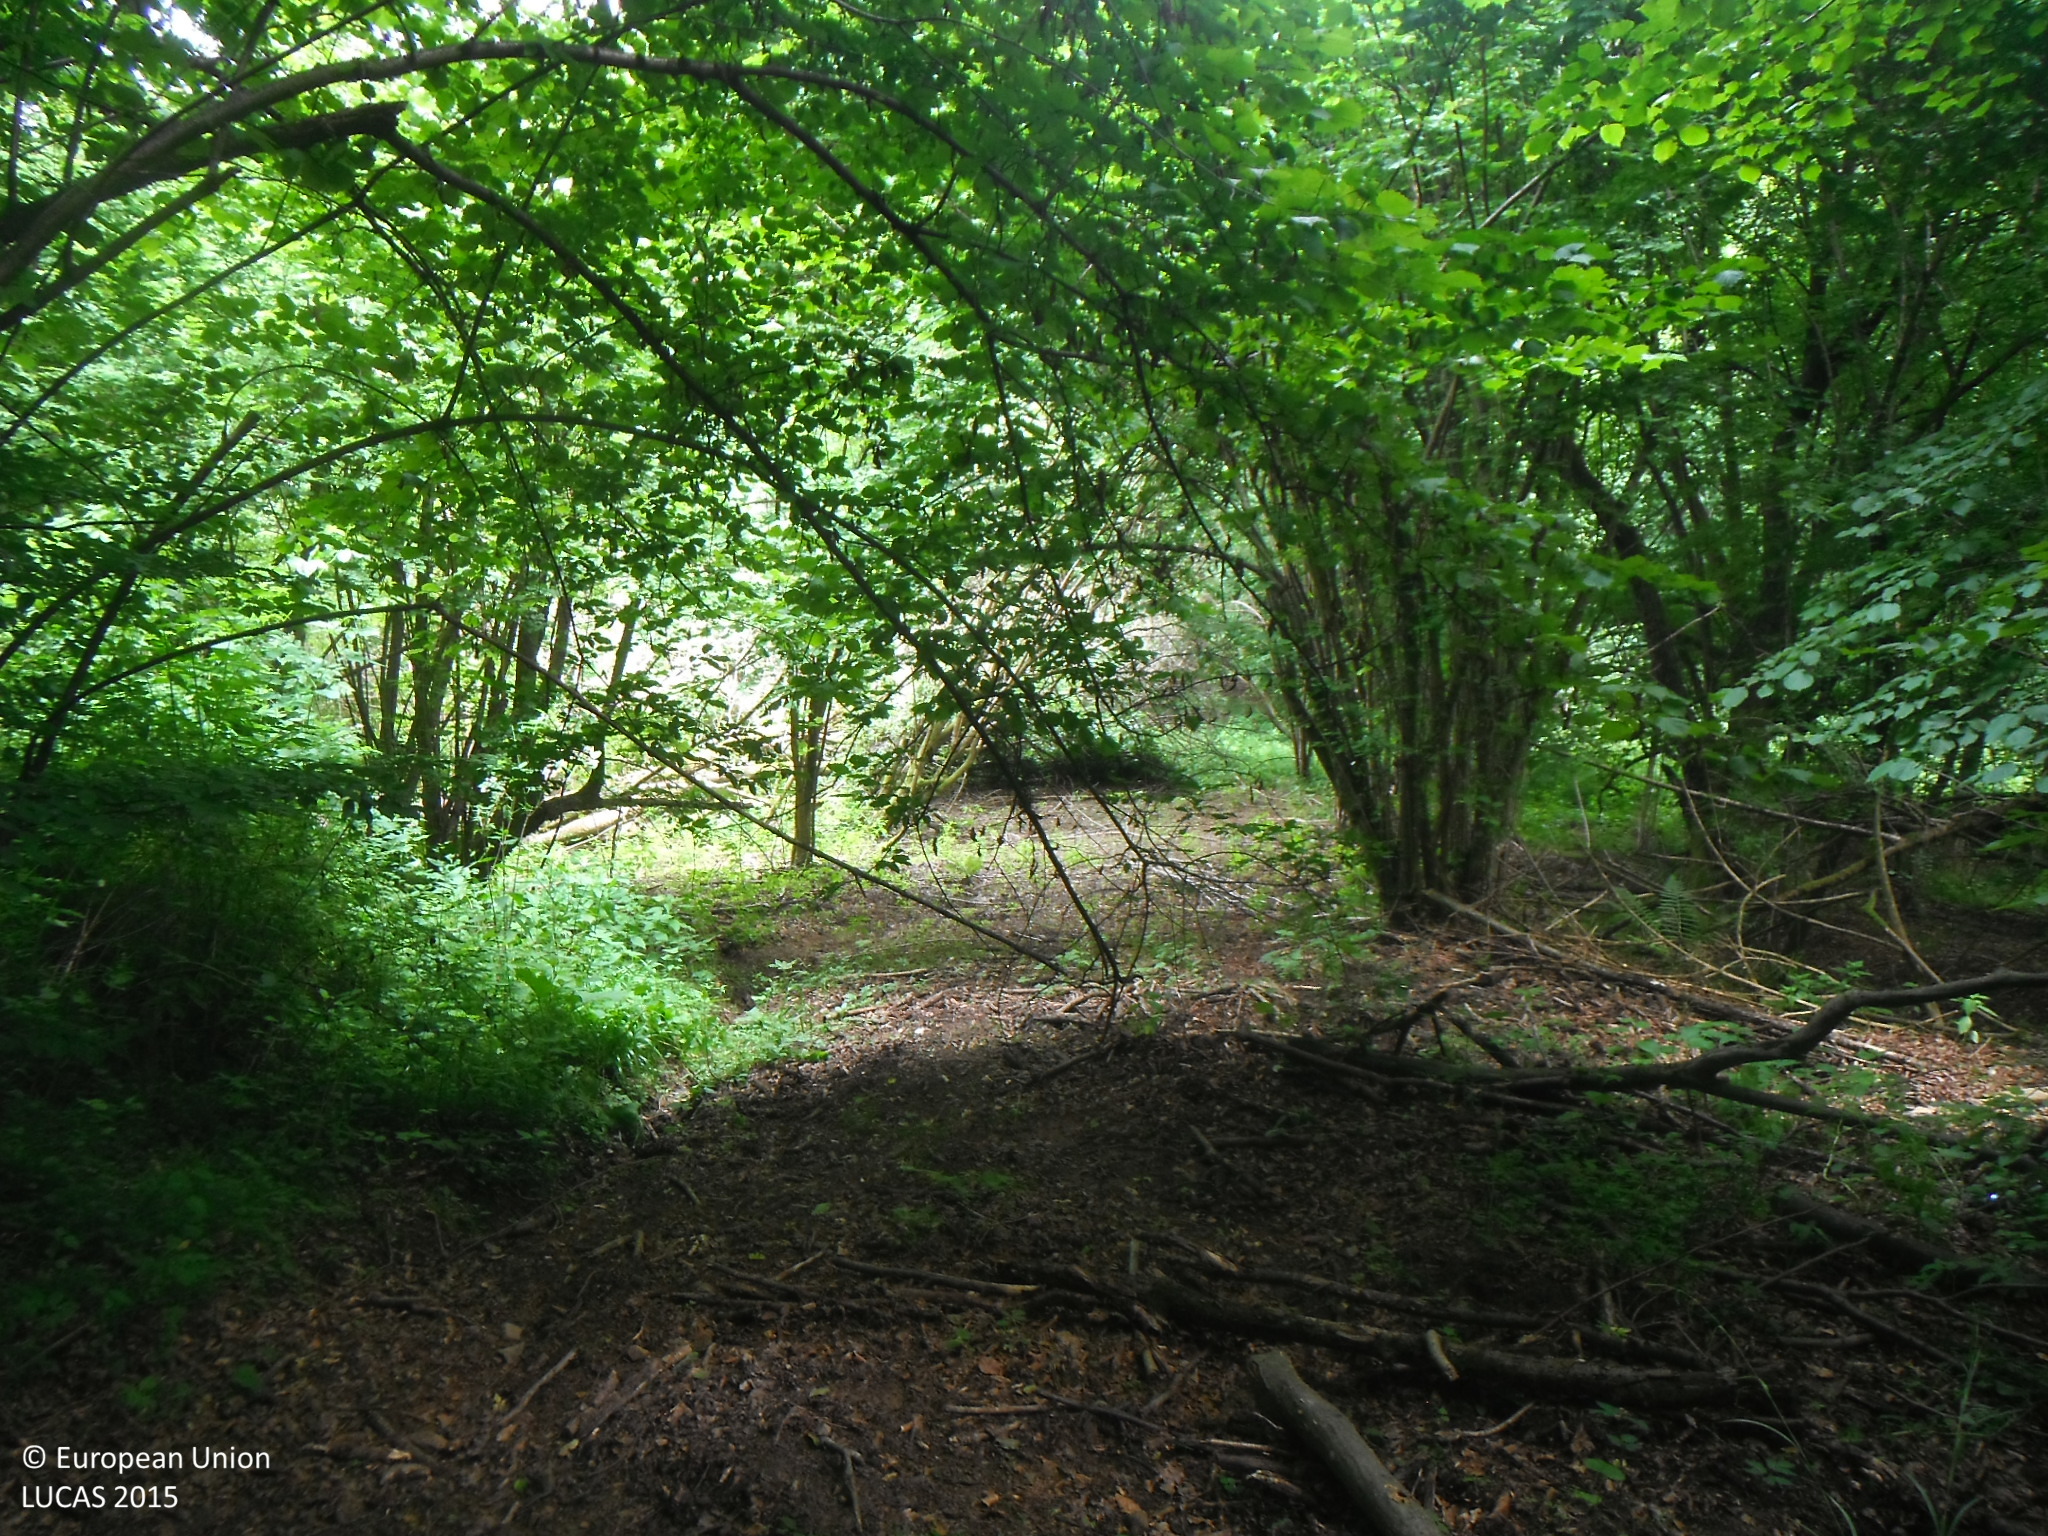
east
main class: Woodland
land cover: Broadleaved woodland
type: beech forest
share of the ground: > 75 %
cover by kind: broadleaved forest trees 90 %, herbaceous plants 5 %, consolidated bare surface 5 %
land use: Forestry
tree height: > 5 m
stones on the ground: < 10 %
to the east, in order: Broadleaved woodland; Rivers and streams; Broadleaved woodland; Grass margins; Paved roads, cycling and walking lanes; Grass margins; Broadleaved woodland
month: June
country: SK
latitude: 48.9915
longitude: 21.9307
